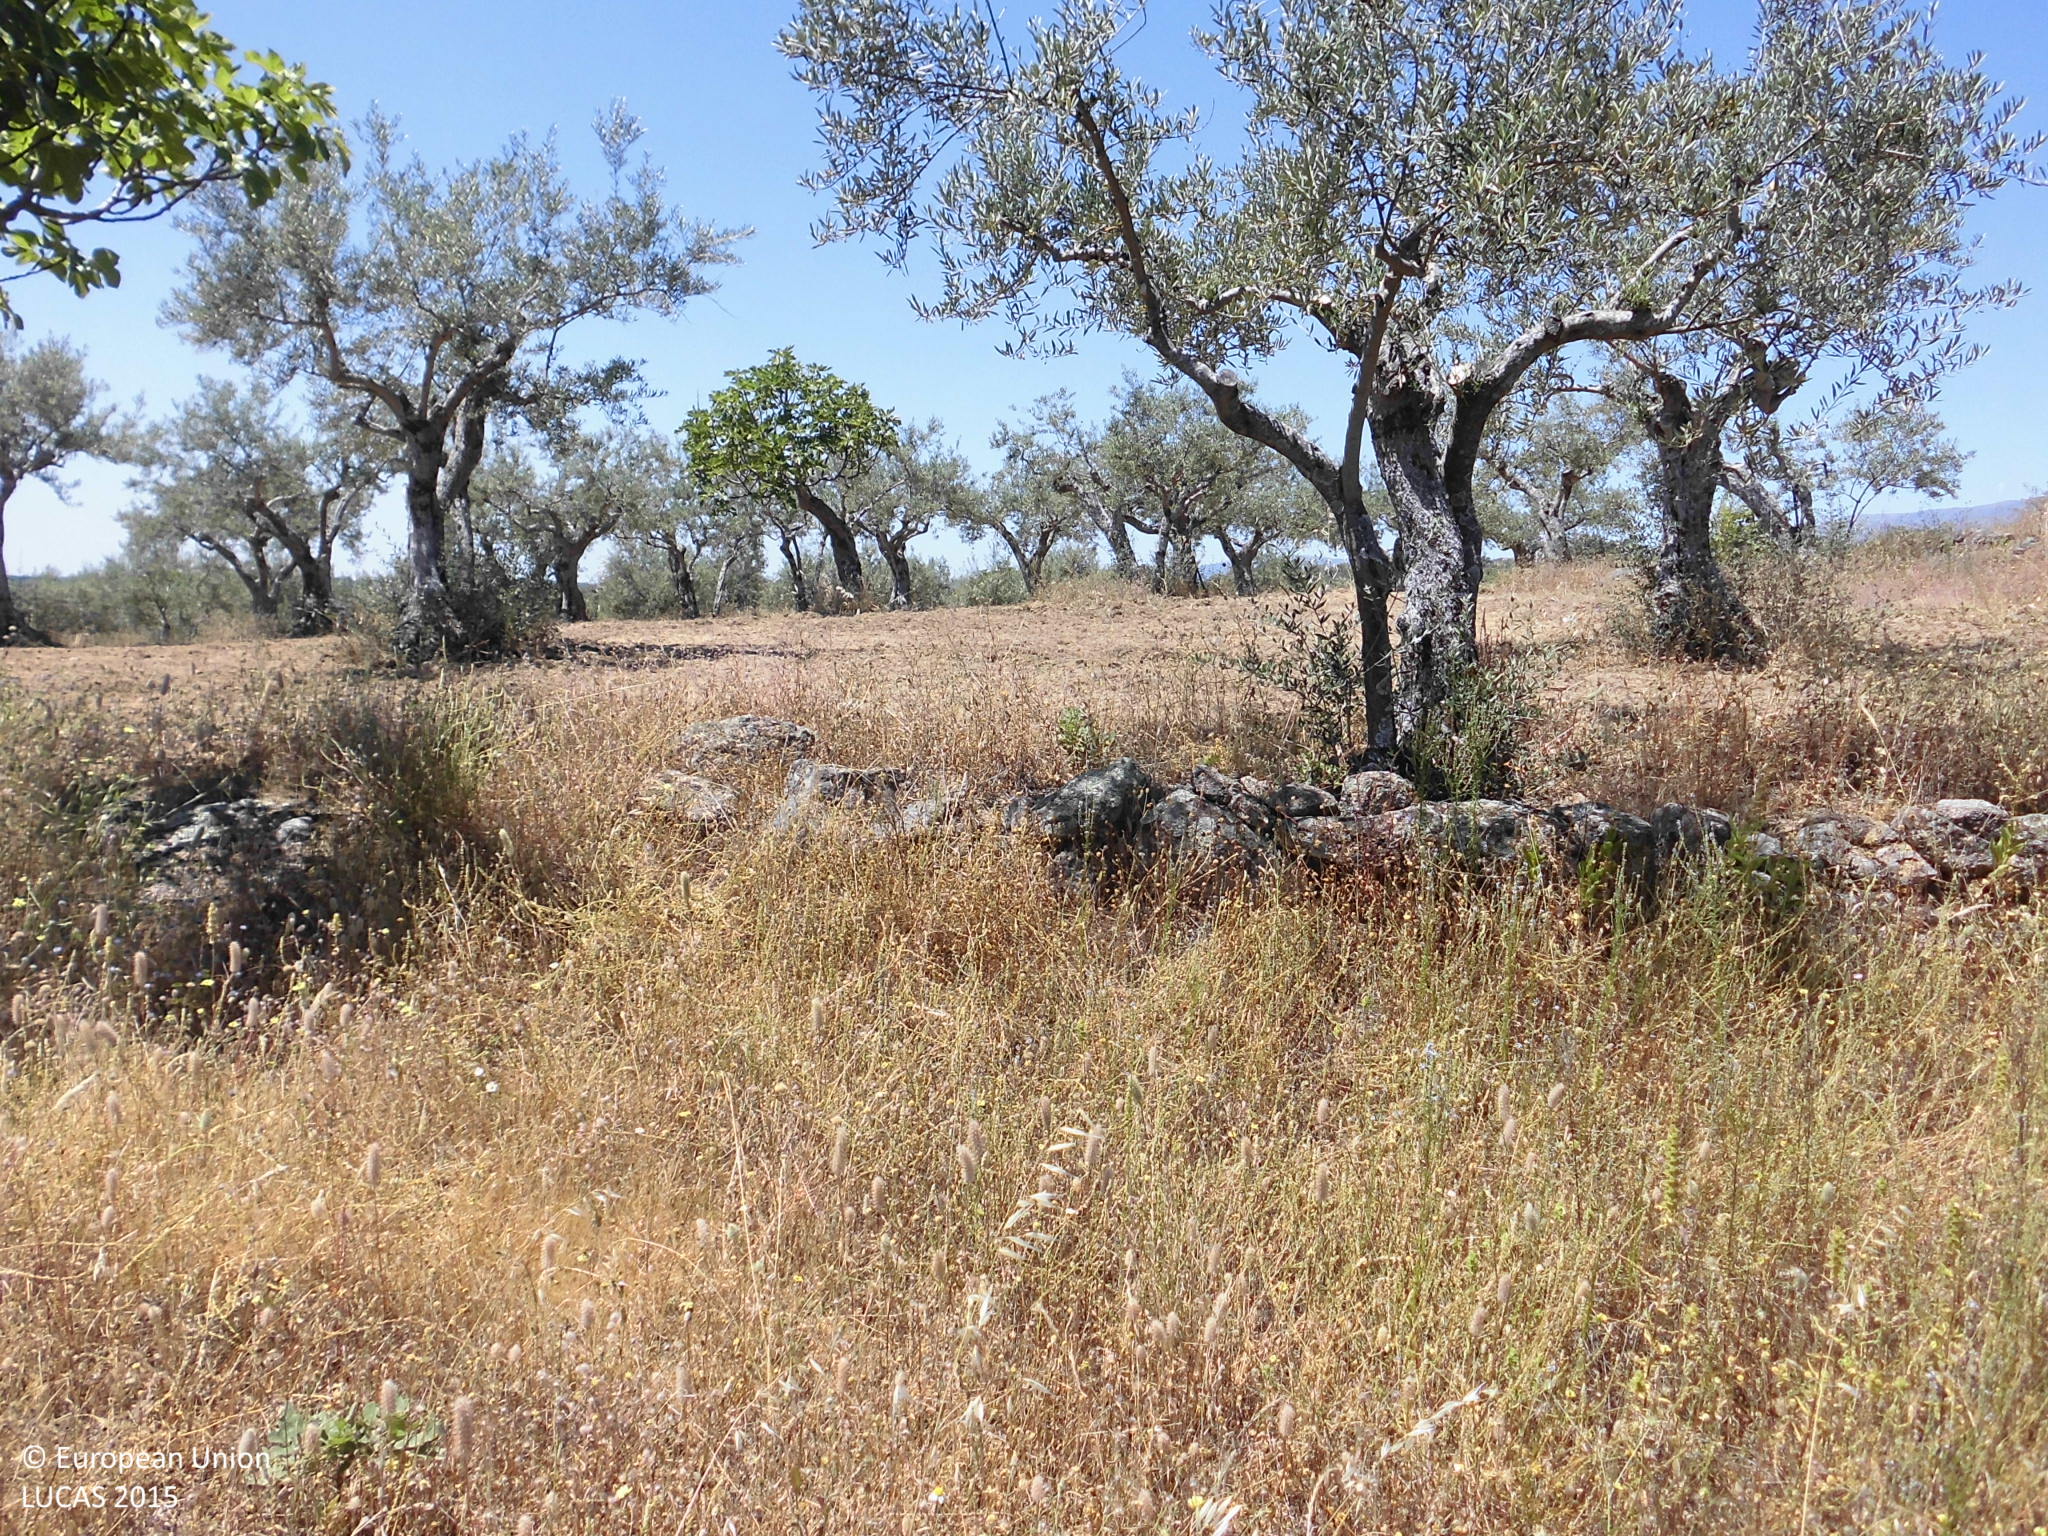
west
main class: Woodland
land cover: Broadleaved woodland
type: broadleaved evergreen forest
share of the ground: 25 - 50 %
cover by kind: herbaceous plants 55 %, broadleaved forest trees 35 %, shrubs 10 %
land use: Forestry
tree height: > 5 m
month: June
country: ES
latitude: 40.1059
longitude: -5.5358
